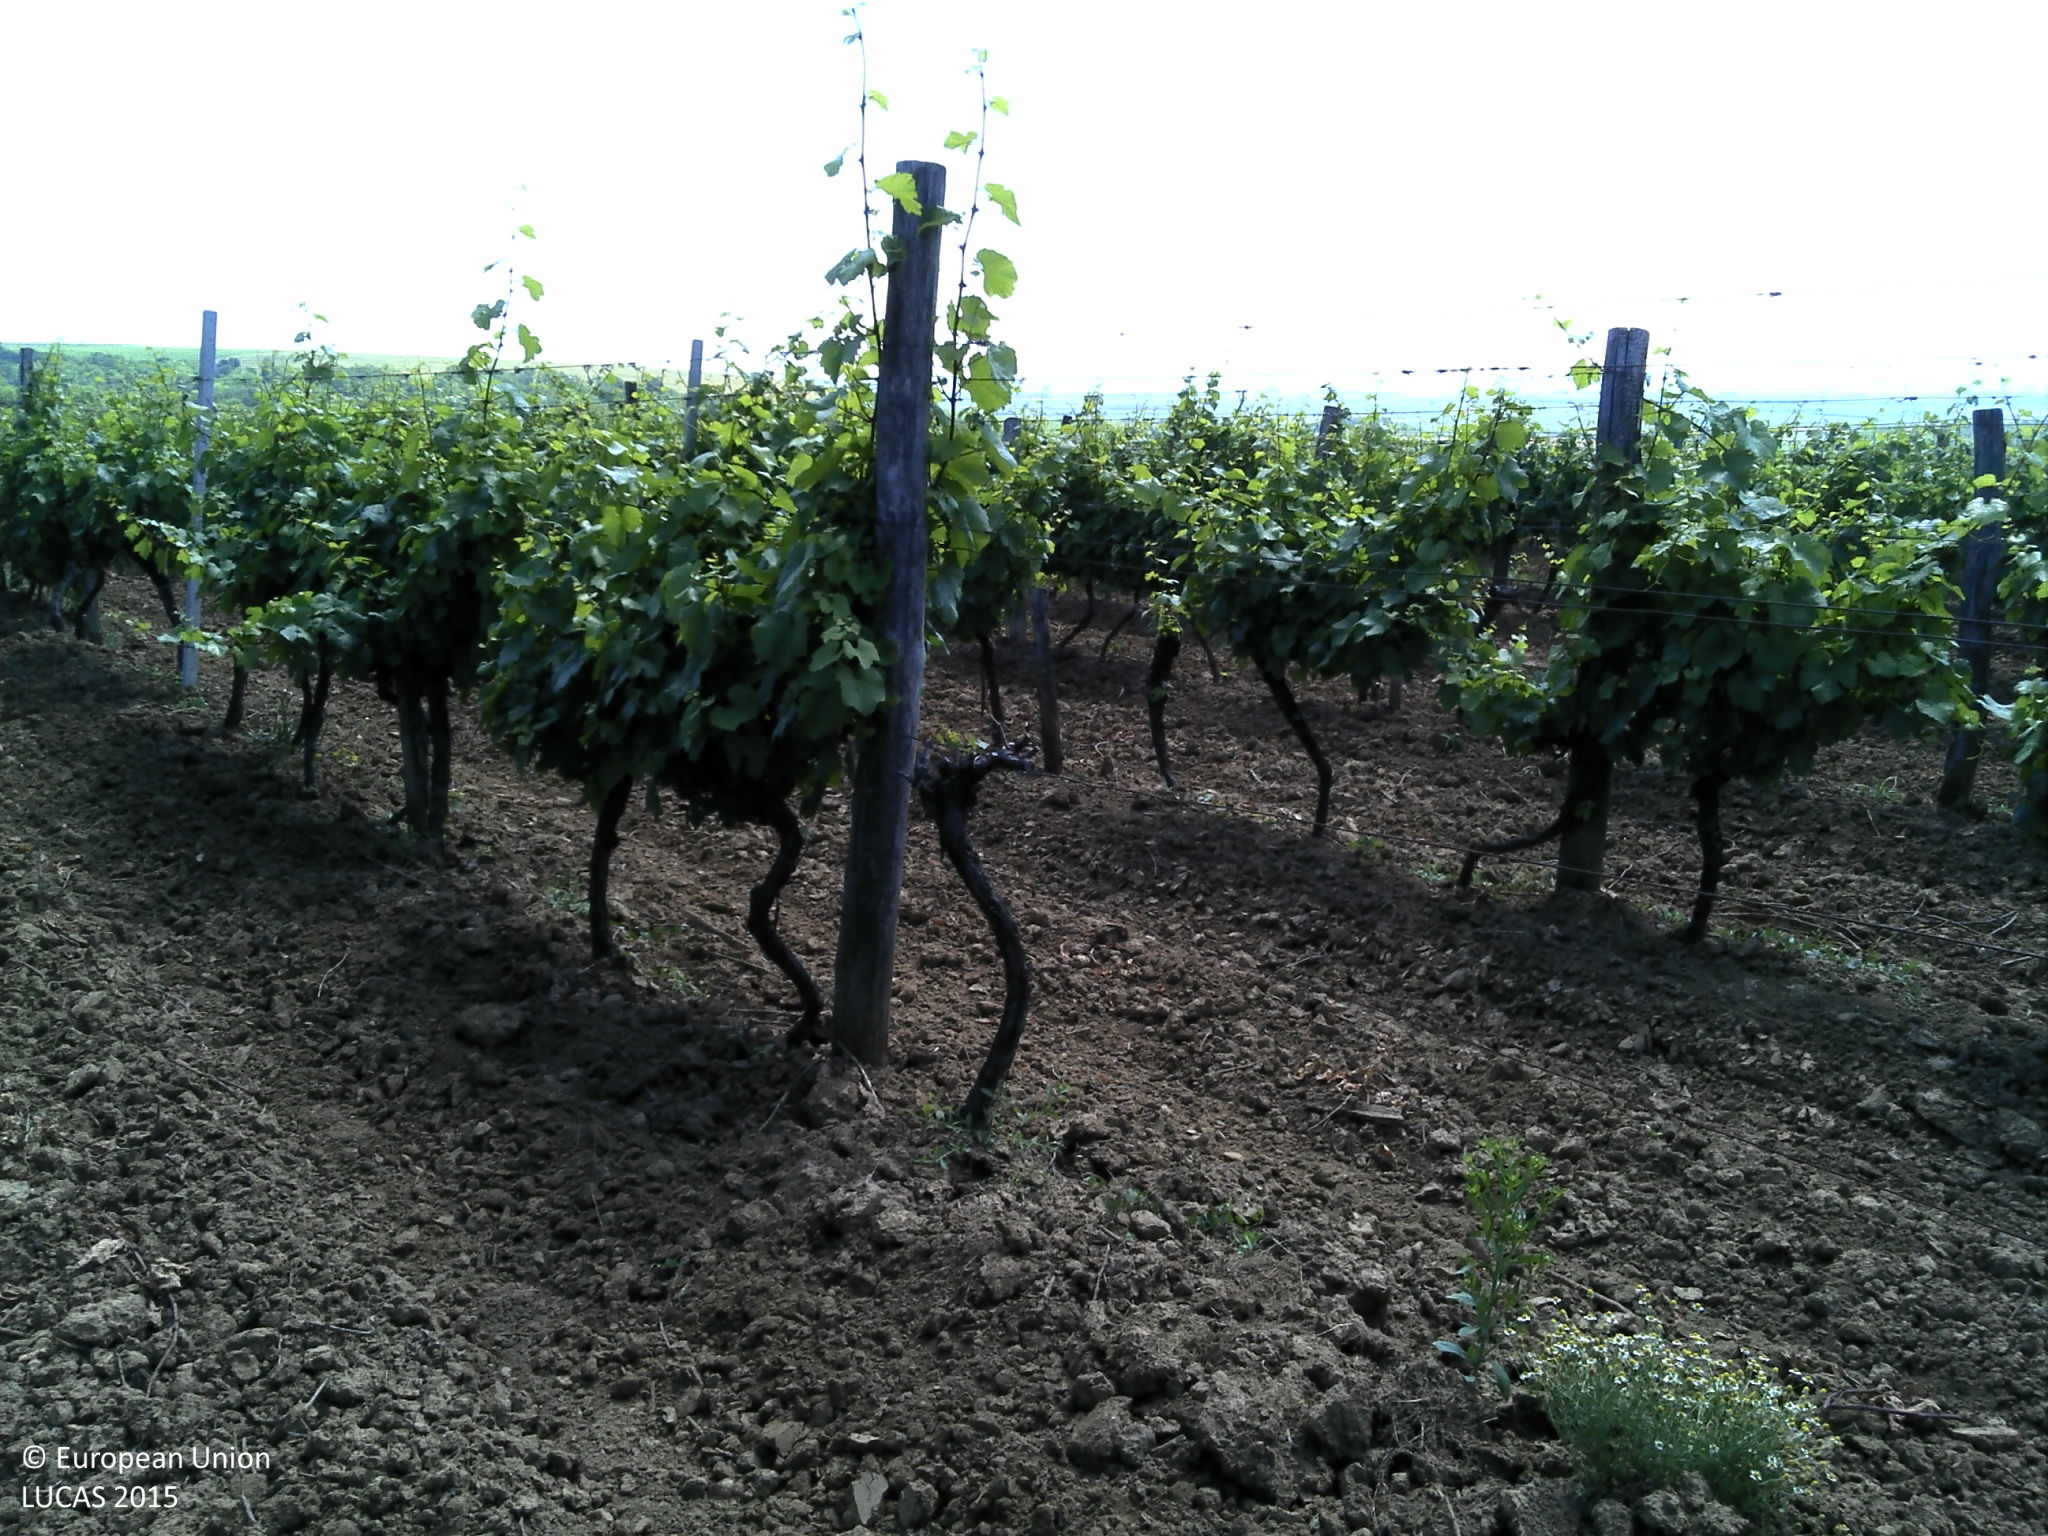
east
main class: Cropland
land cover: Vineyards
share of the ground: 25 - 50 %
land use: Agriculture (excluding fallow land and kitchen gardens)
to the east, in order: Vineyards; Other bare soil; Vineyards; Grassland without tree/shrub cover; Electric lines; Ditches and canals; Grass margins; Tracks; Grass margins; Shruby margins; Broadleaved woodland
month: June
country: HR
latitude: 45.7796
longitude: 18.6902
